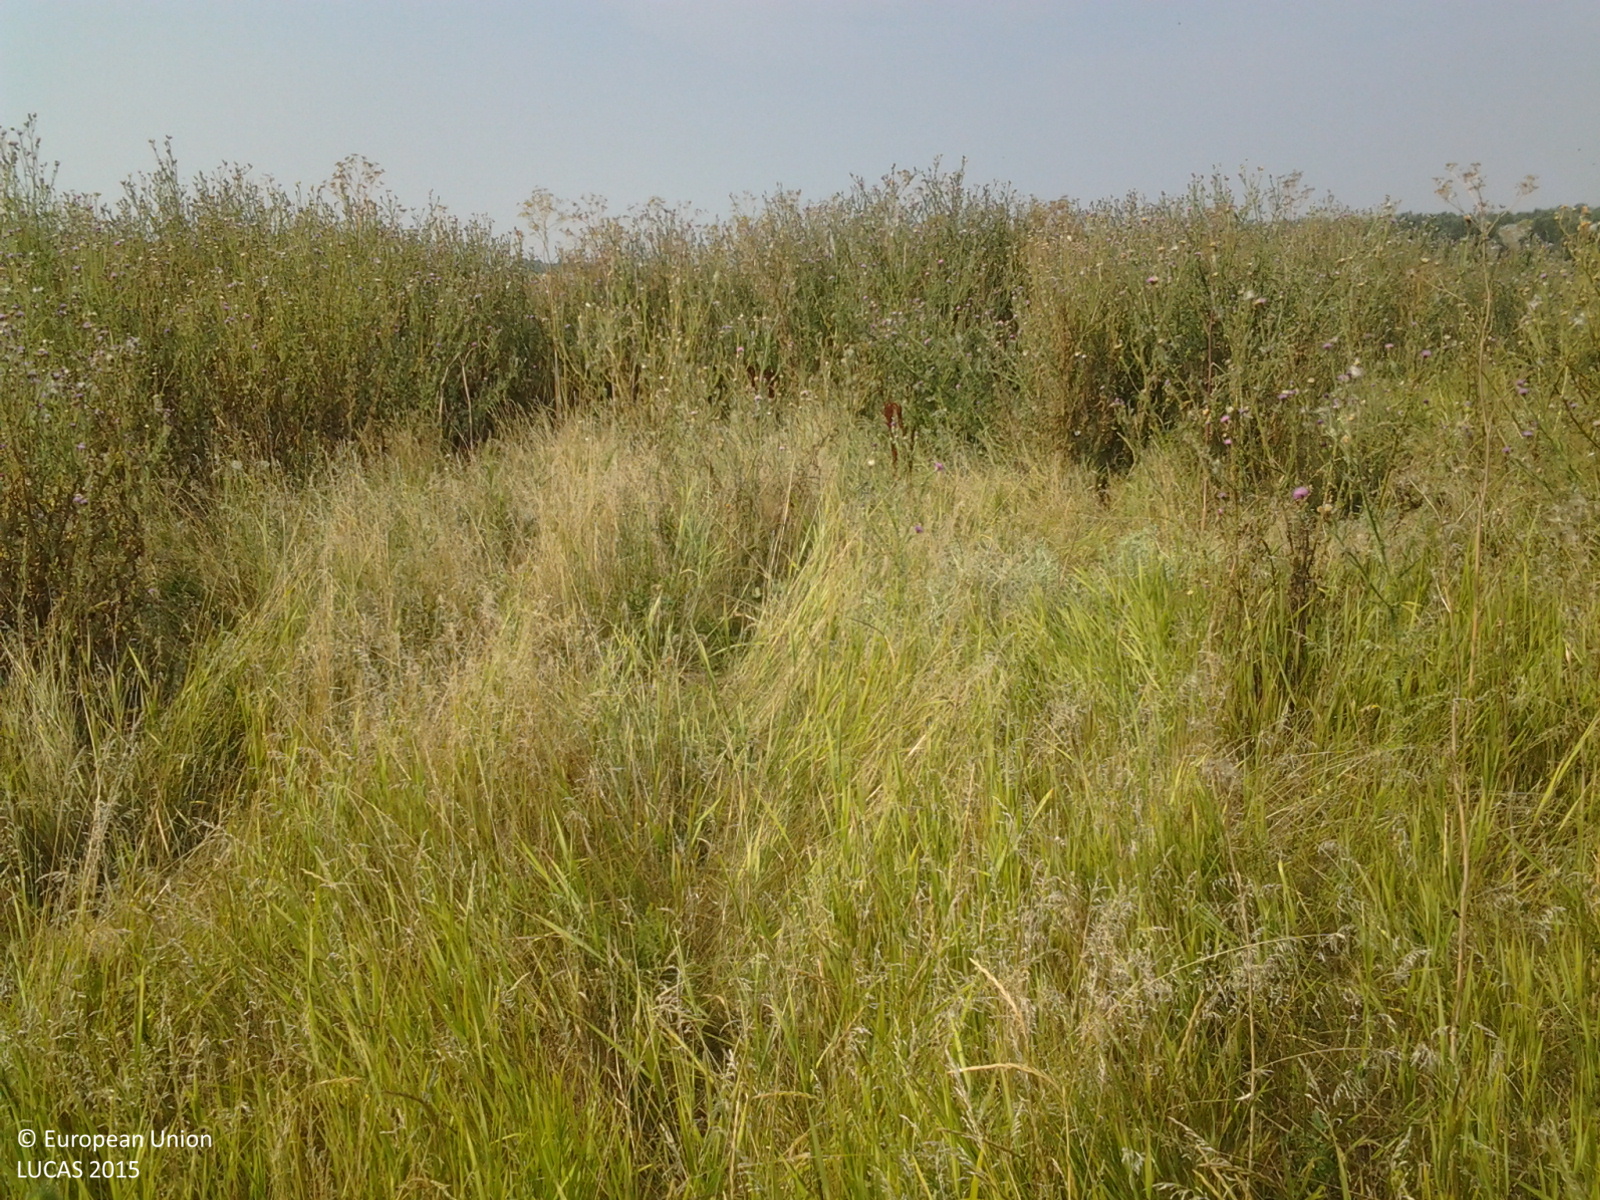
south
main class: Grassland
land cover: Grassland without tree/shrub cover
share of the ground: > 75 %
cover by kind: herbaceous plants 100 %
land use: Agriculture (excluding fallow land and kitchen gardens)
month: July
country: HU
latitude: 46.7916
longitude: 21.4226
